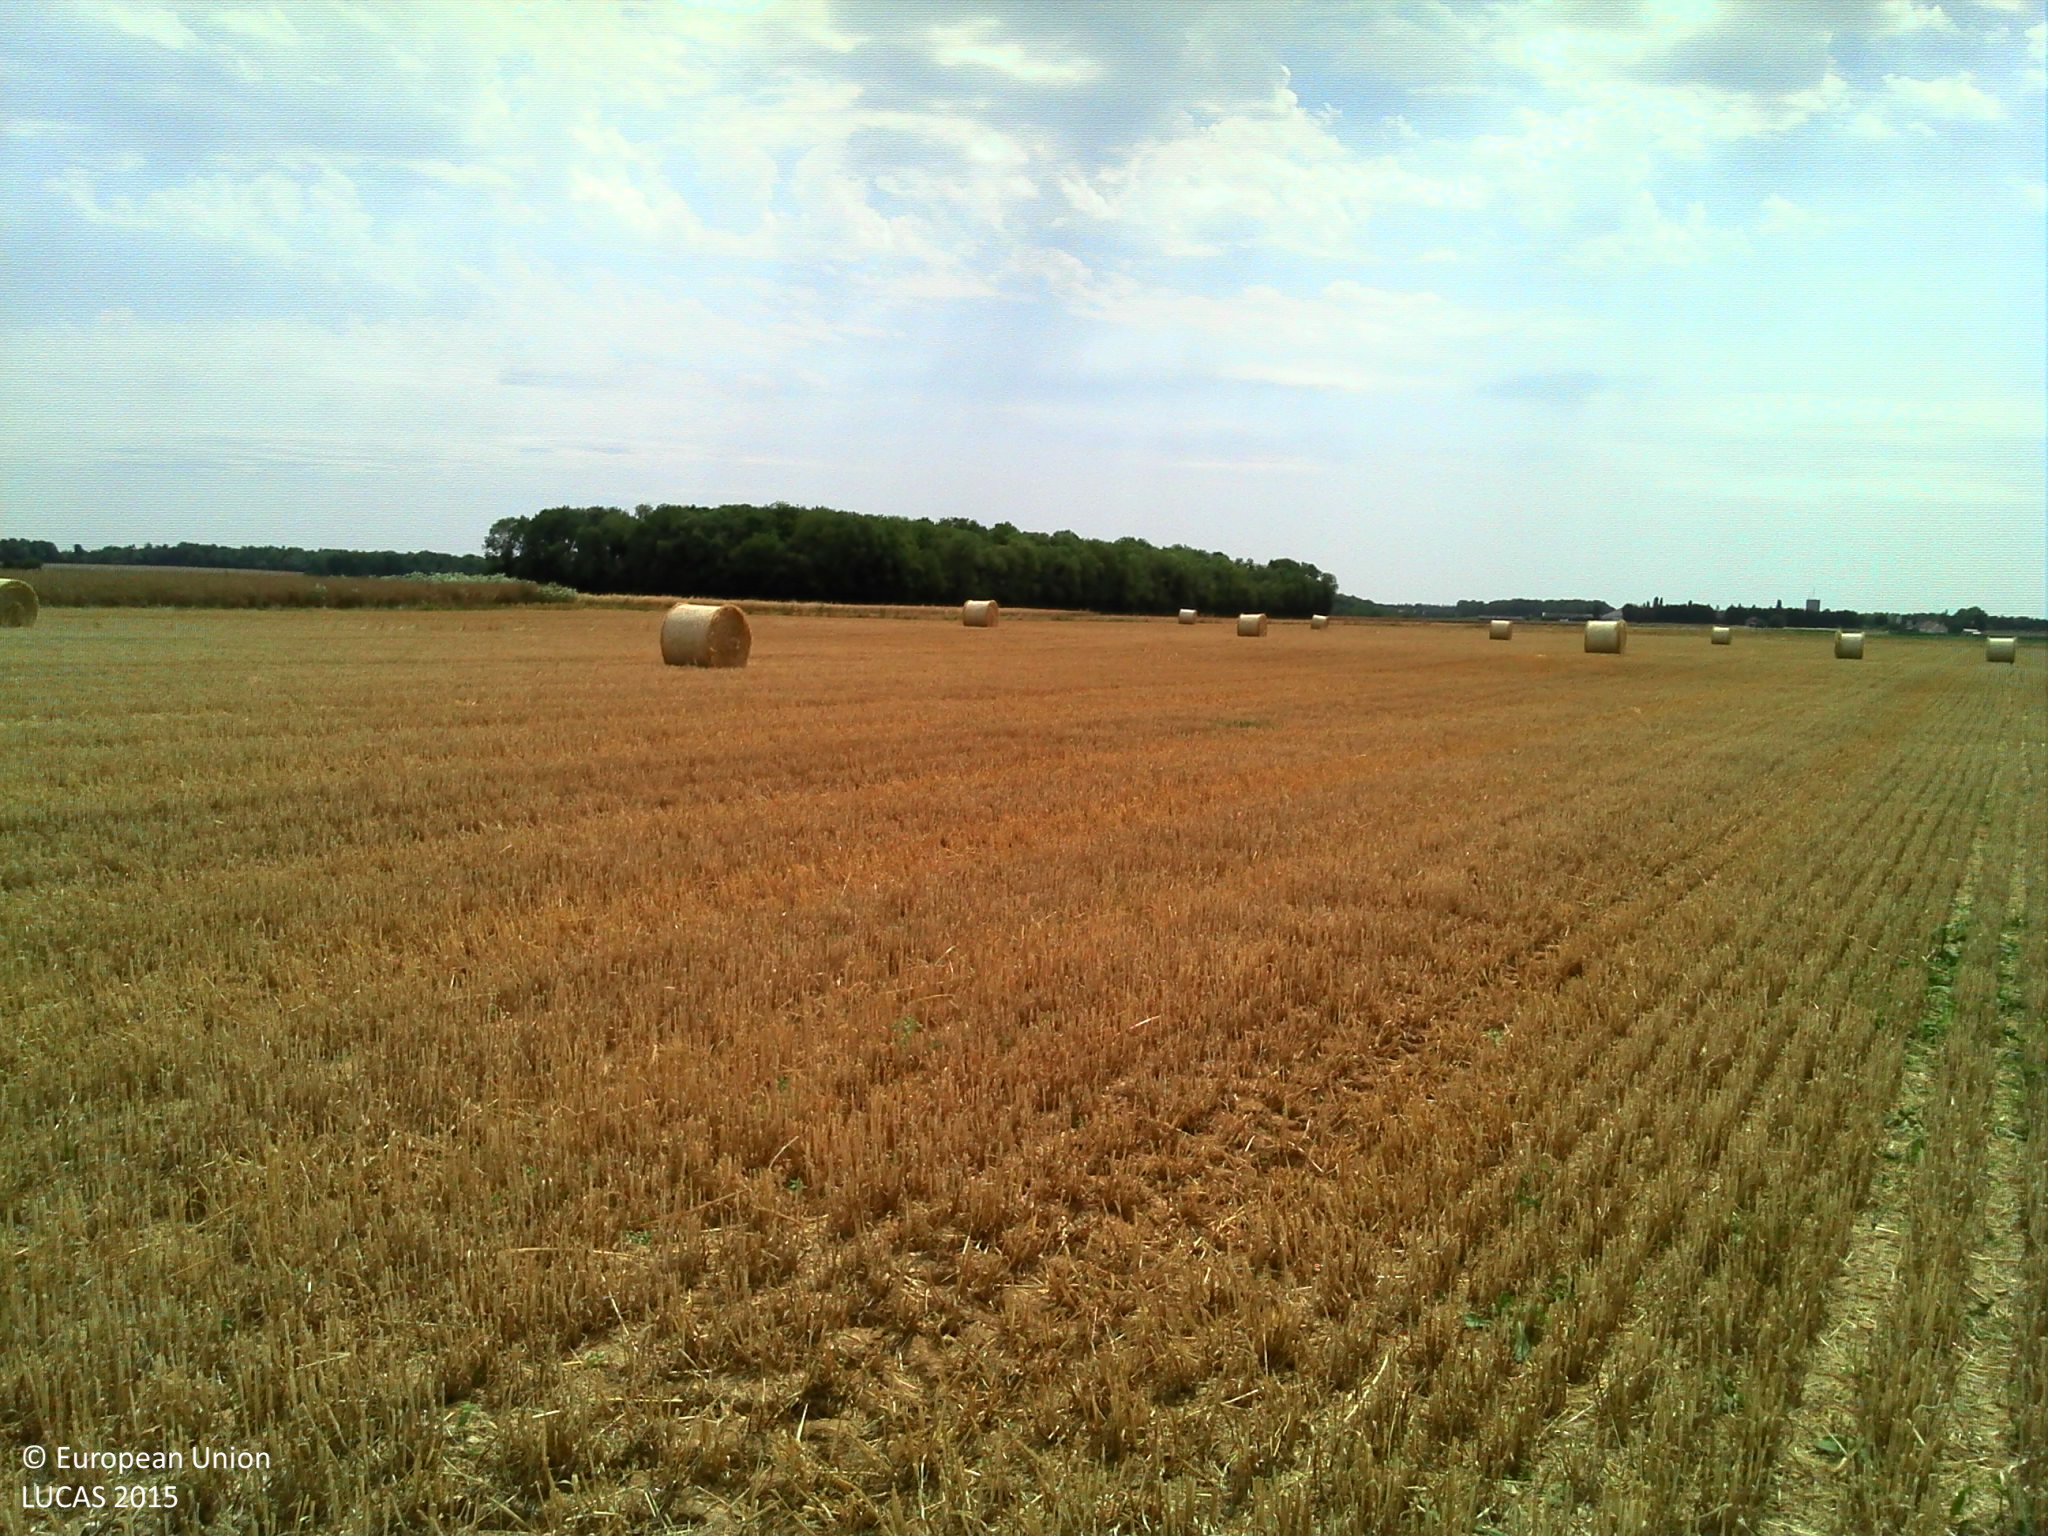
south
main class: Cropland
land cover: Barley
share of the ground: > 75 %
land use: Agriculture (excluding fallow land and kitchen gardens)
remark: Harvested field
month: July
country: FR
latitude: 49.0142
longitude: -0.2469
